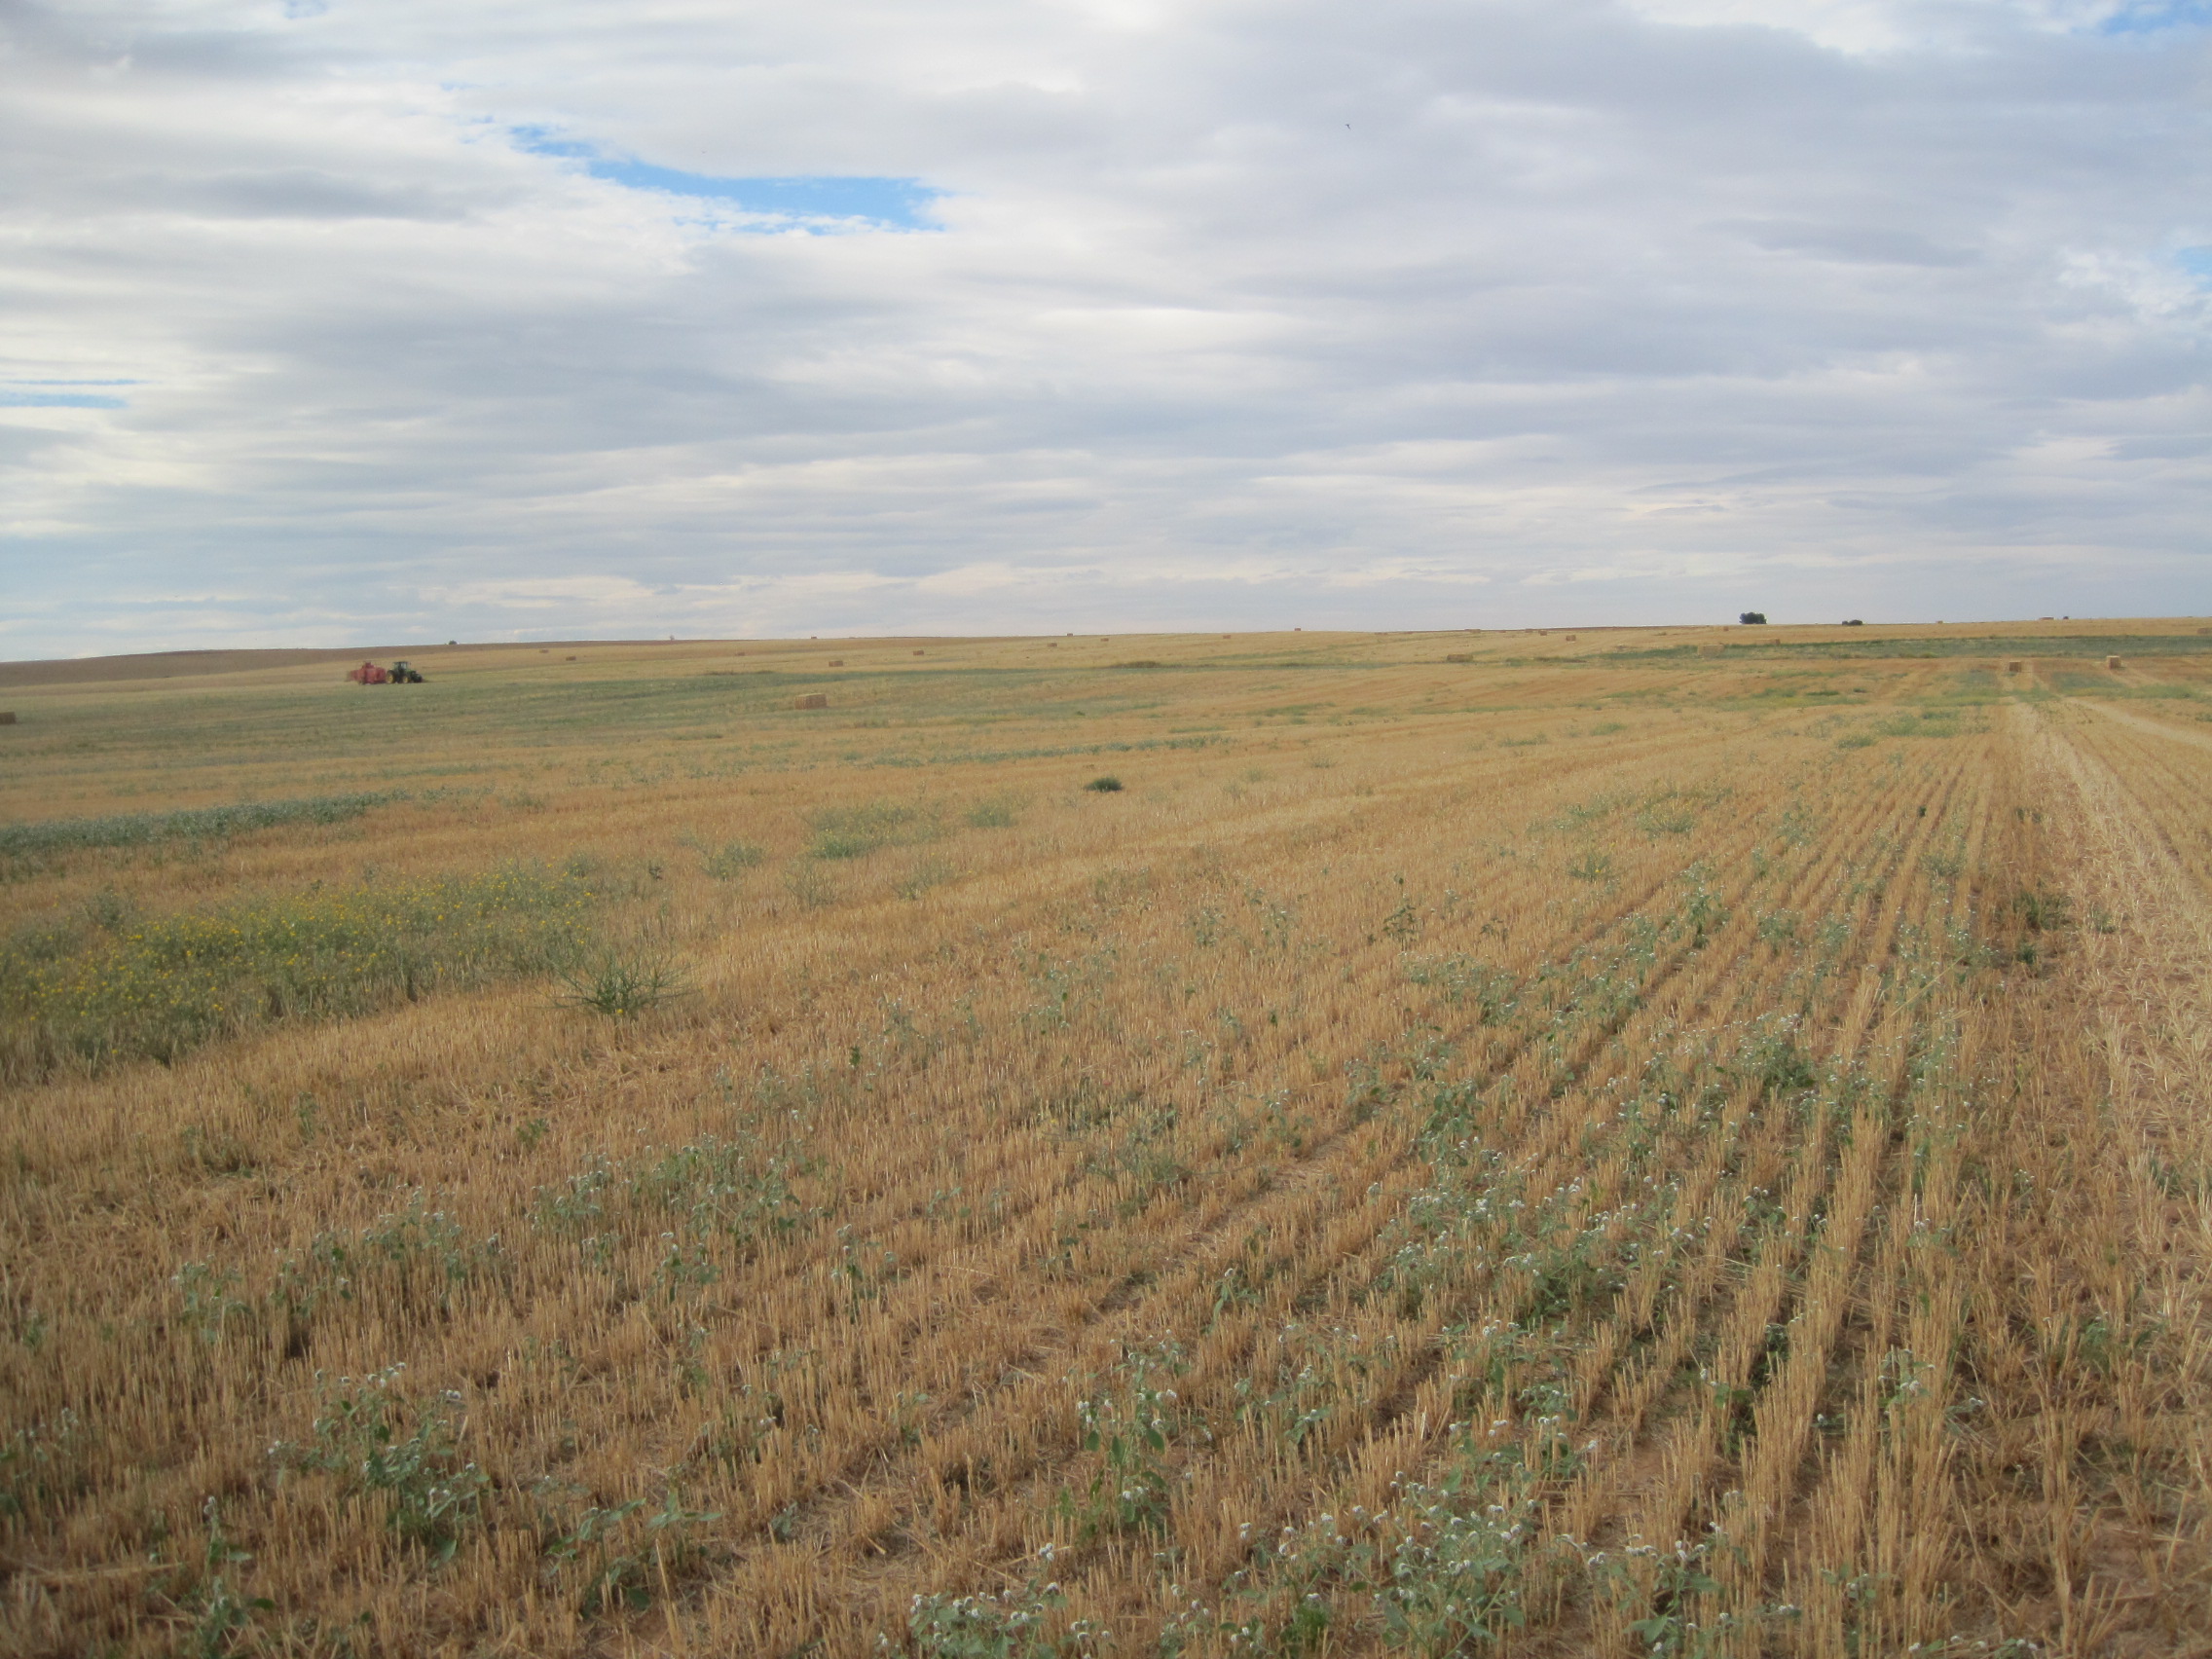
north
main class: Cropland
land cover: Barley
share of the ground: < 10 %
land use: Agriculture (excluding fallow land and kitchen gardens)
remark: Harvested field
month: July
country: ES
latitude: 41.9669
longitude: -5.4966
